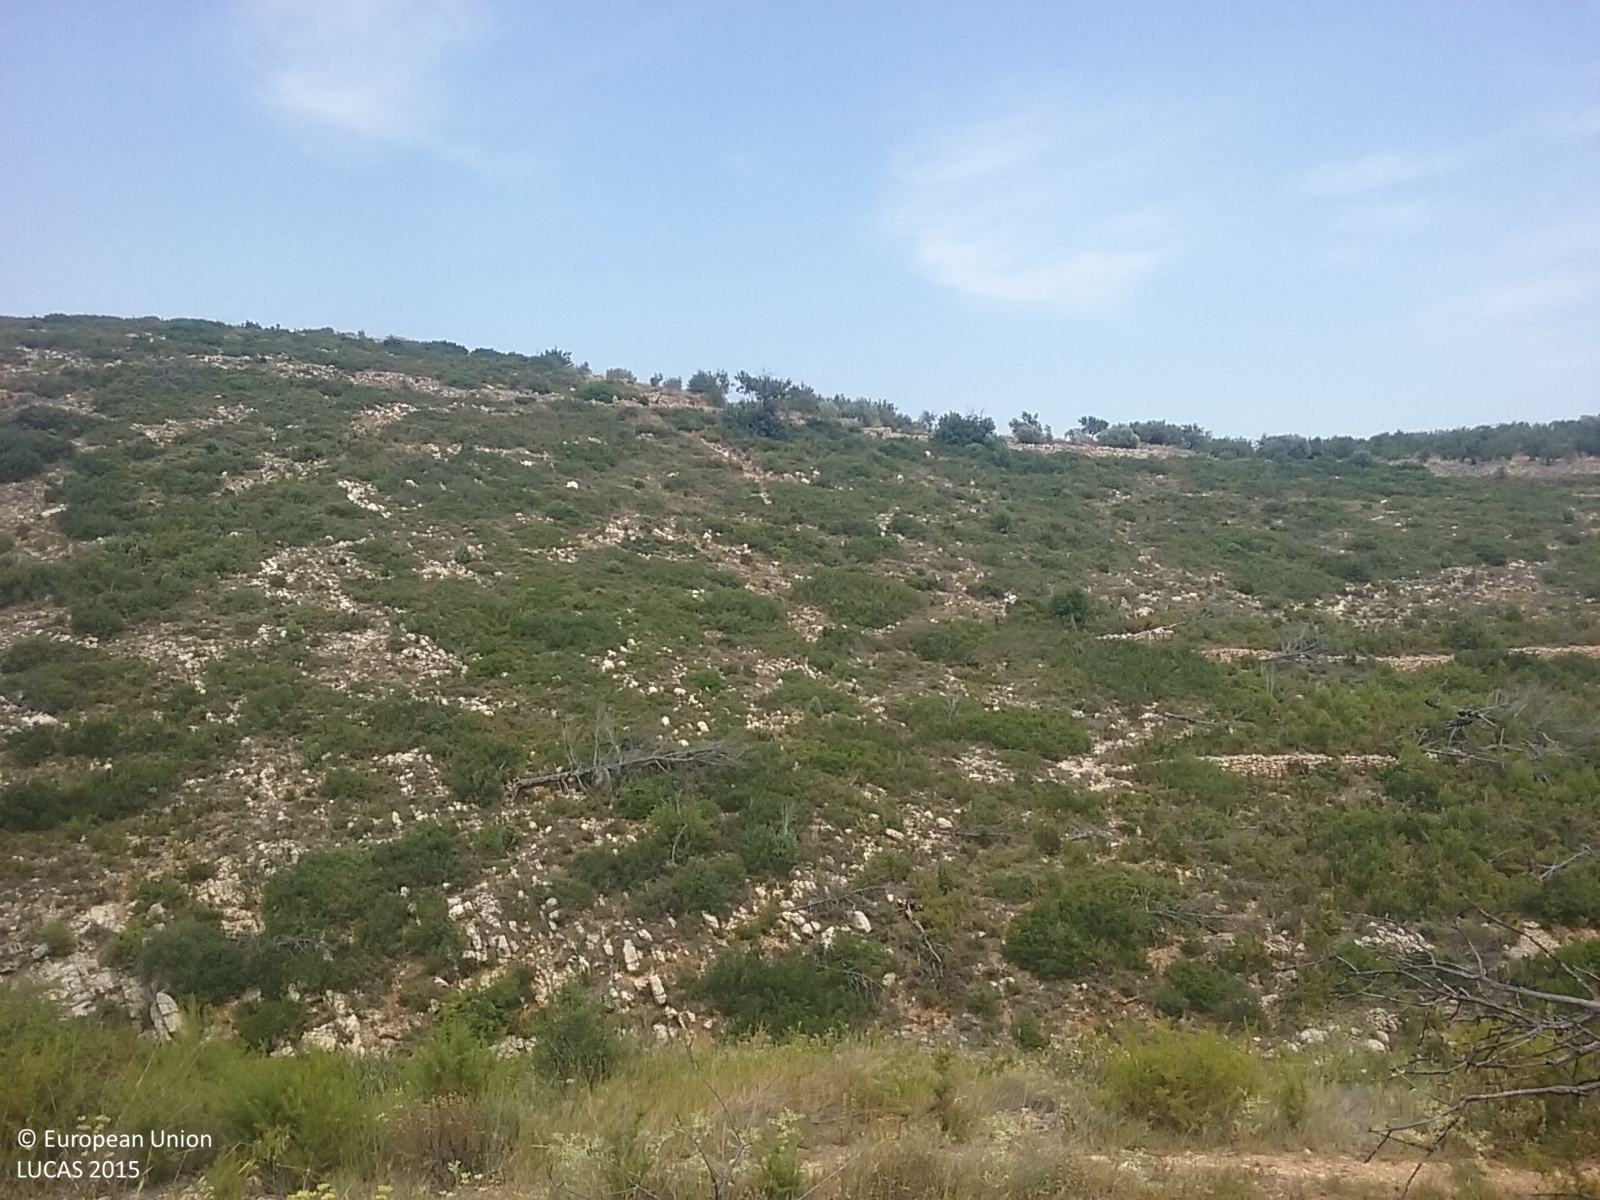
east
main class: Shrubland
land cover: Shrubland with sparse tree cover
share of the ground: > 75 %
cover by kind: shrubs 80 %, herbaceous plants 15 %, coniferous forest trees 5 %
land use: Semi-natural and natural areas not in use
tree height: < 5 m
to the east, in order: Shrubland with sparse tree cover; Tracks; Shrubland with sparse tree cover; Dry stone walls; Shrubland with sparse tree cover; Dry stone walls; Shrubland with sparse tree cover; Dry stone walls; Inland fresh running water; Shrubland with sparse tree cover; Dry stone walls; Shrubland with sparse tree cover; Dry stone walls; Shrubland with sparse tree cover; Dry stone walls; Shrubland with sparse tree cover; Dry stone walls; Shrubland with sparse tree cover; Dry stone walls; Shrubland with sparse tree cover; Dry stone walls; Shrubland with sparse tree cover; Dry stone walls; Shrubland with sparse tree cover; Dry stone walls; Nuts trees; Dry stone walls; Nuts trees; Dry stone walls; Nuts trees; Dry stone walls; Nuts trees
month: July
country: ES
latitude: 40.1757
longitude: -0.1614
